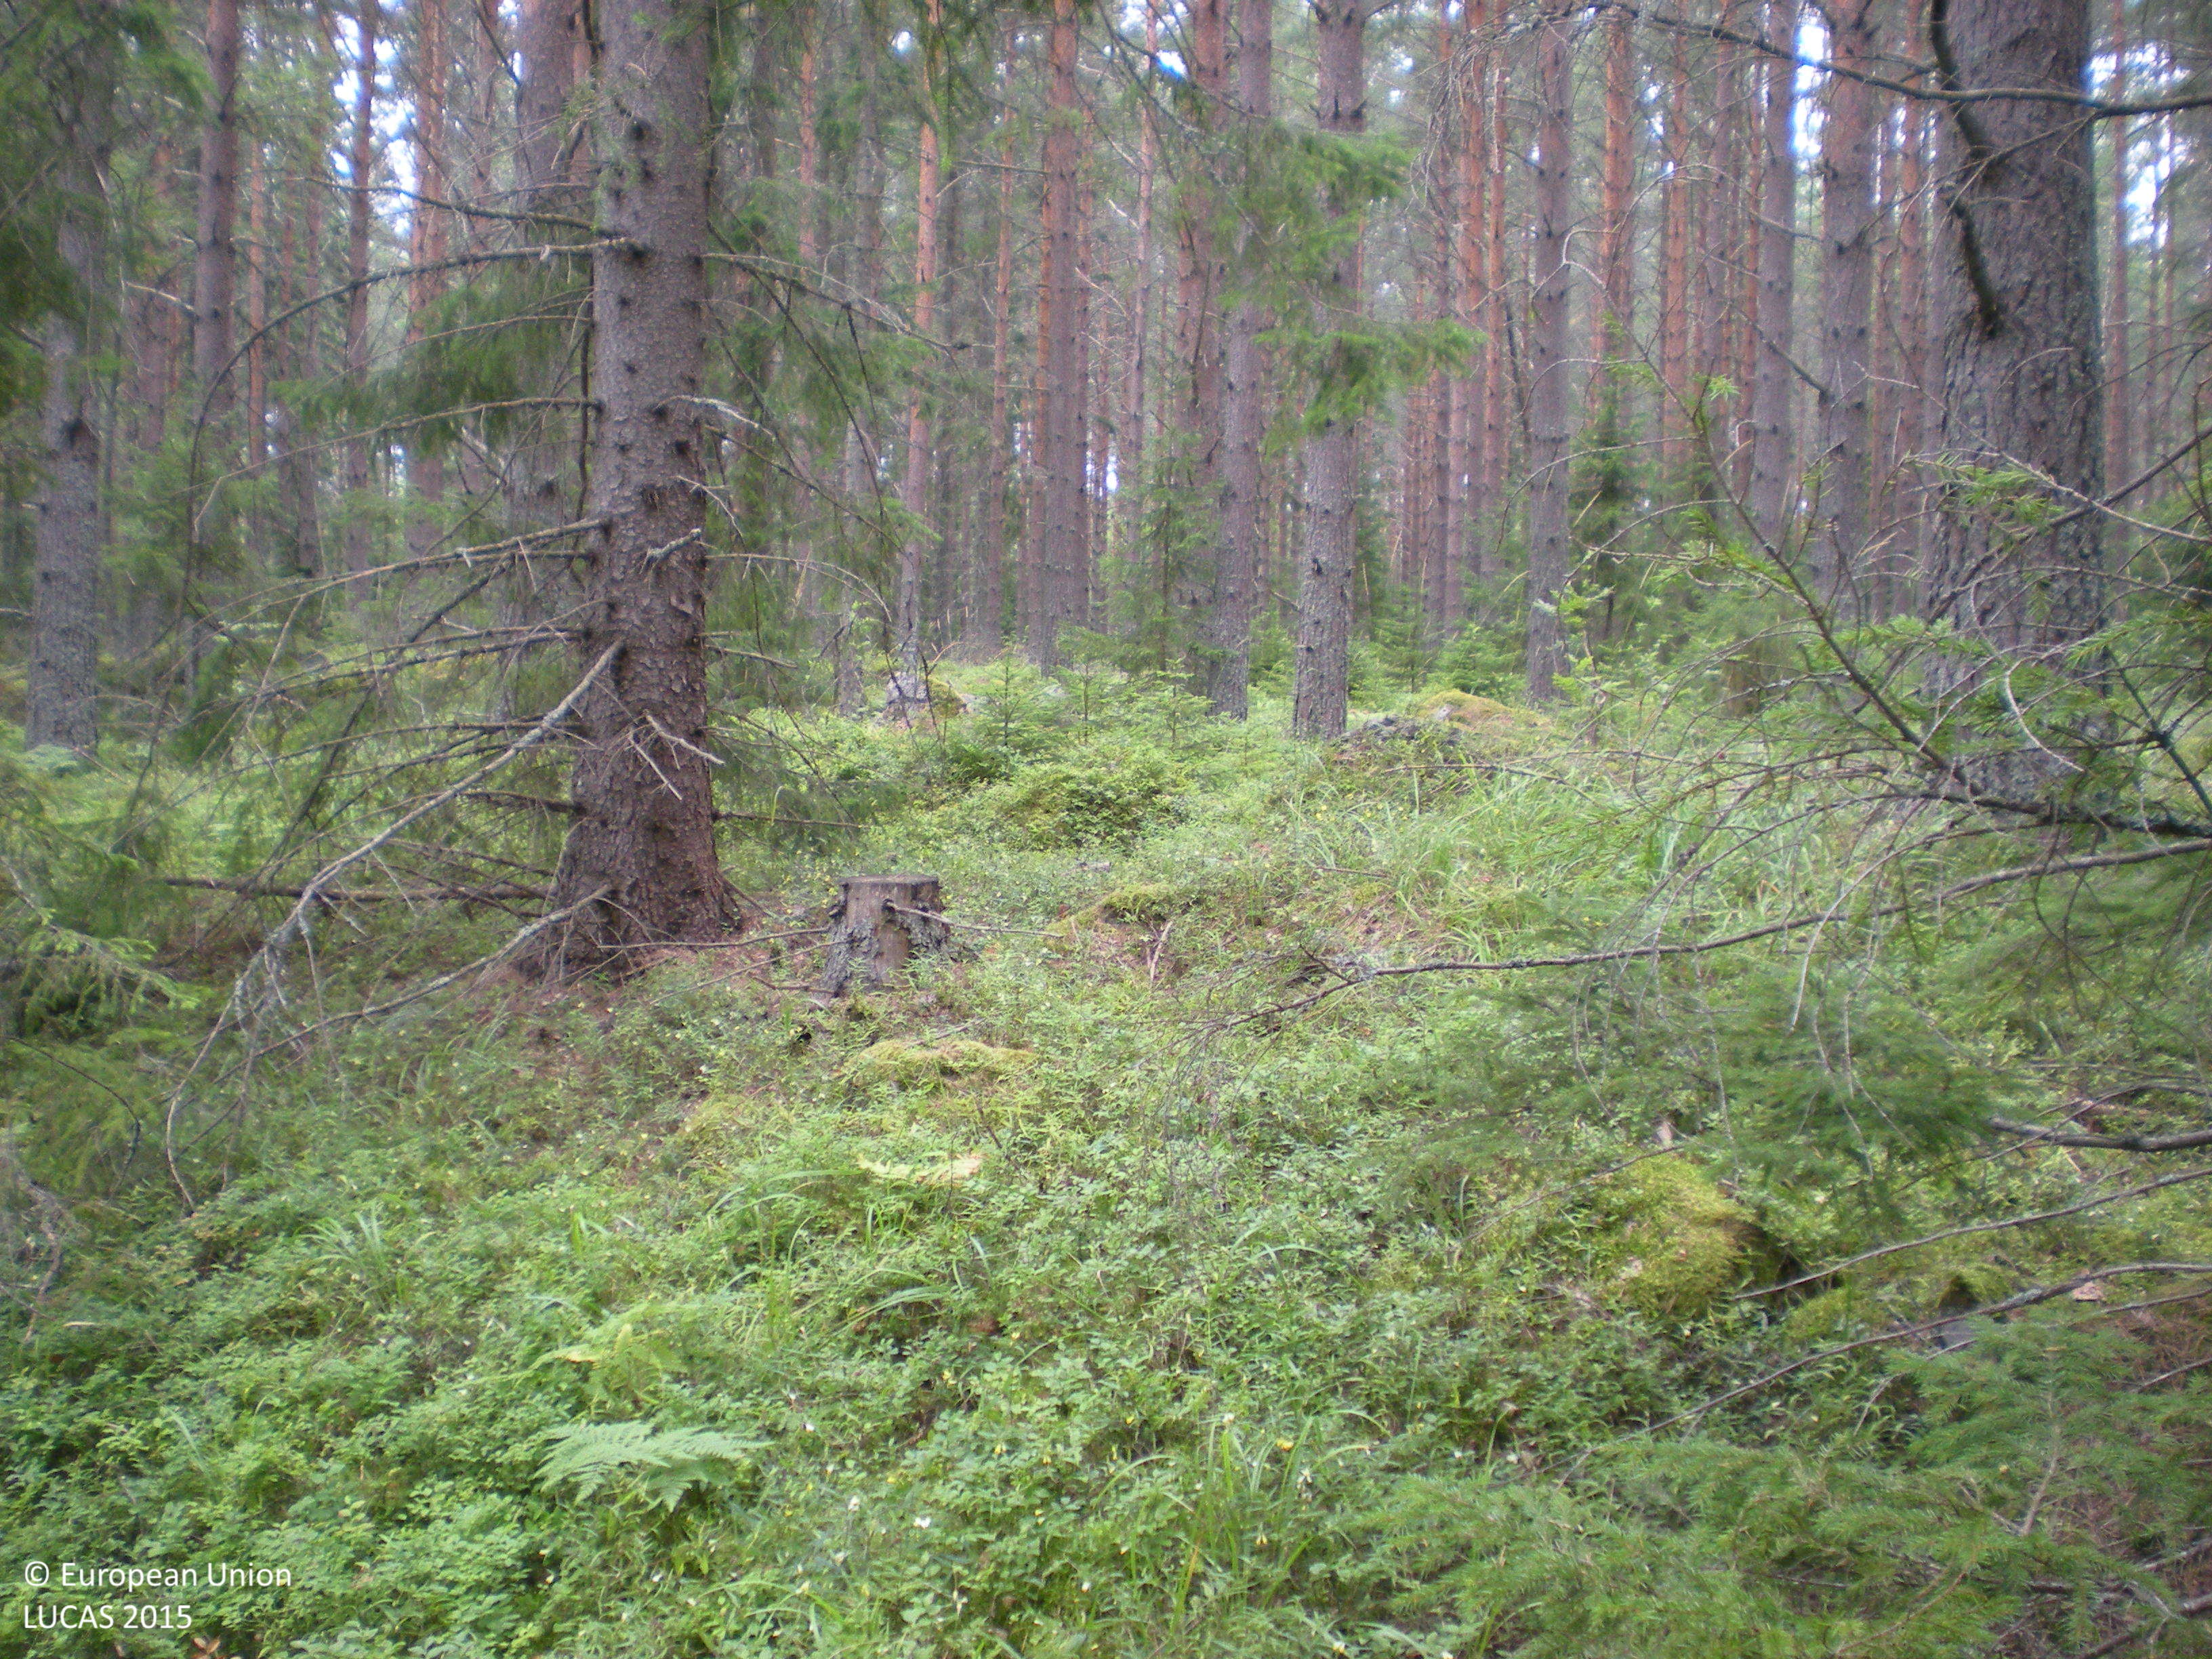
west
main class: Woodland
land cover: Pine dominated coniferous woodland
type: boreal forest
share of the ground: 50 - 75 %
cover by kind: coniferous forest trees 65 %, herbaceous plants 20 %, shrubs 10 %, lichens and mosses 5 %
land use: Forestry
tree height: > 5 m
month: August
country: SE
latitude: 60.7904
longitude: 17.2449
